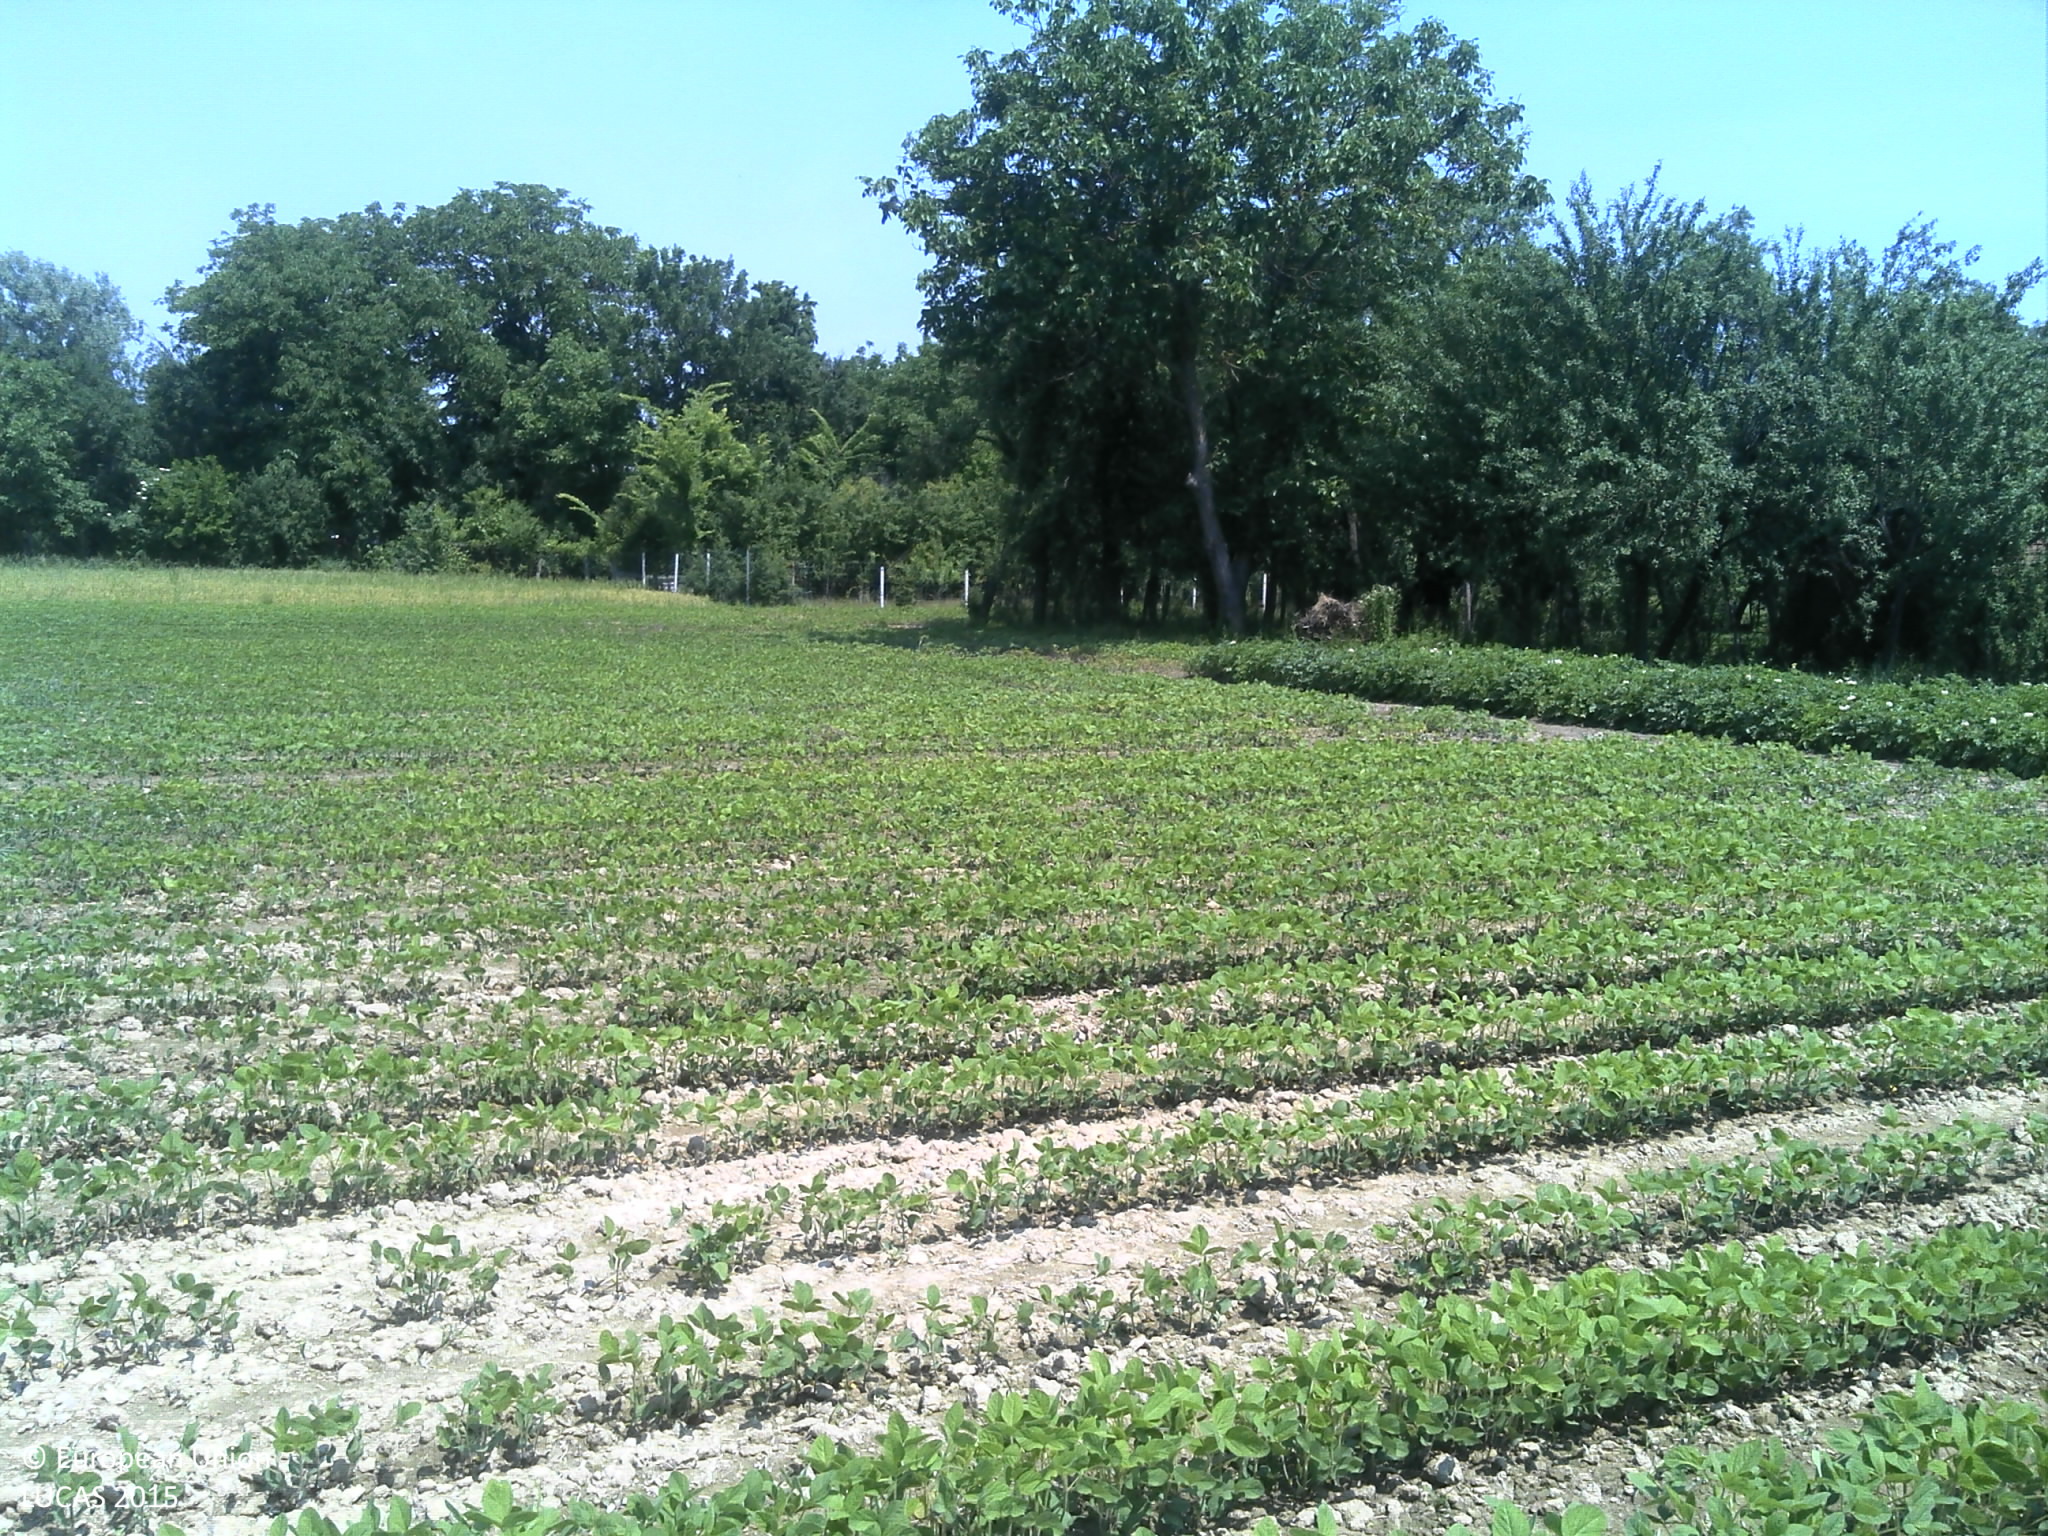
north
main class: Cropland
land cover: Soya
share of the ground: 10 - 25 %
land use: Agriculture (excluding fallow land and kitchen gardens)
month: June
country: HR
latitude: 45.6730
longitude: 17.9761
